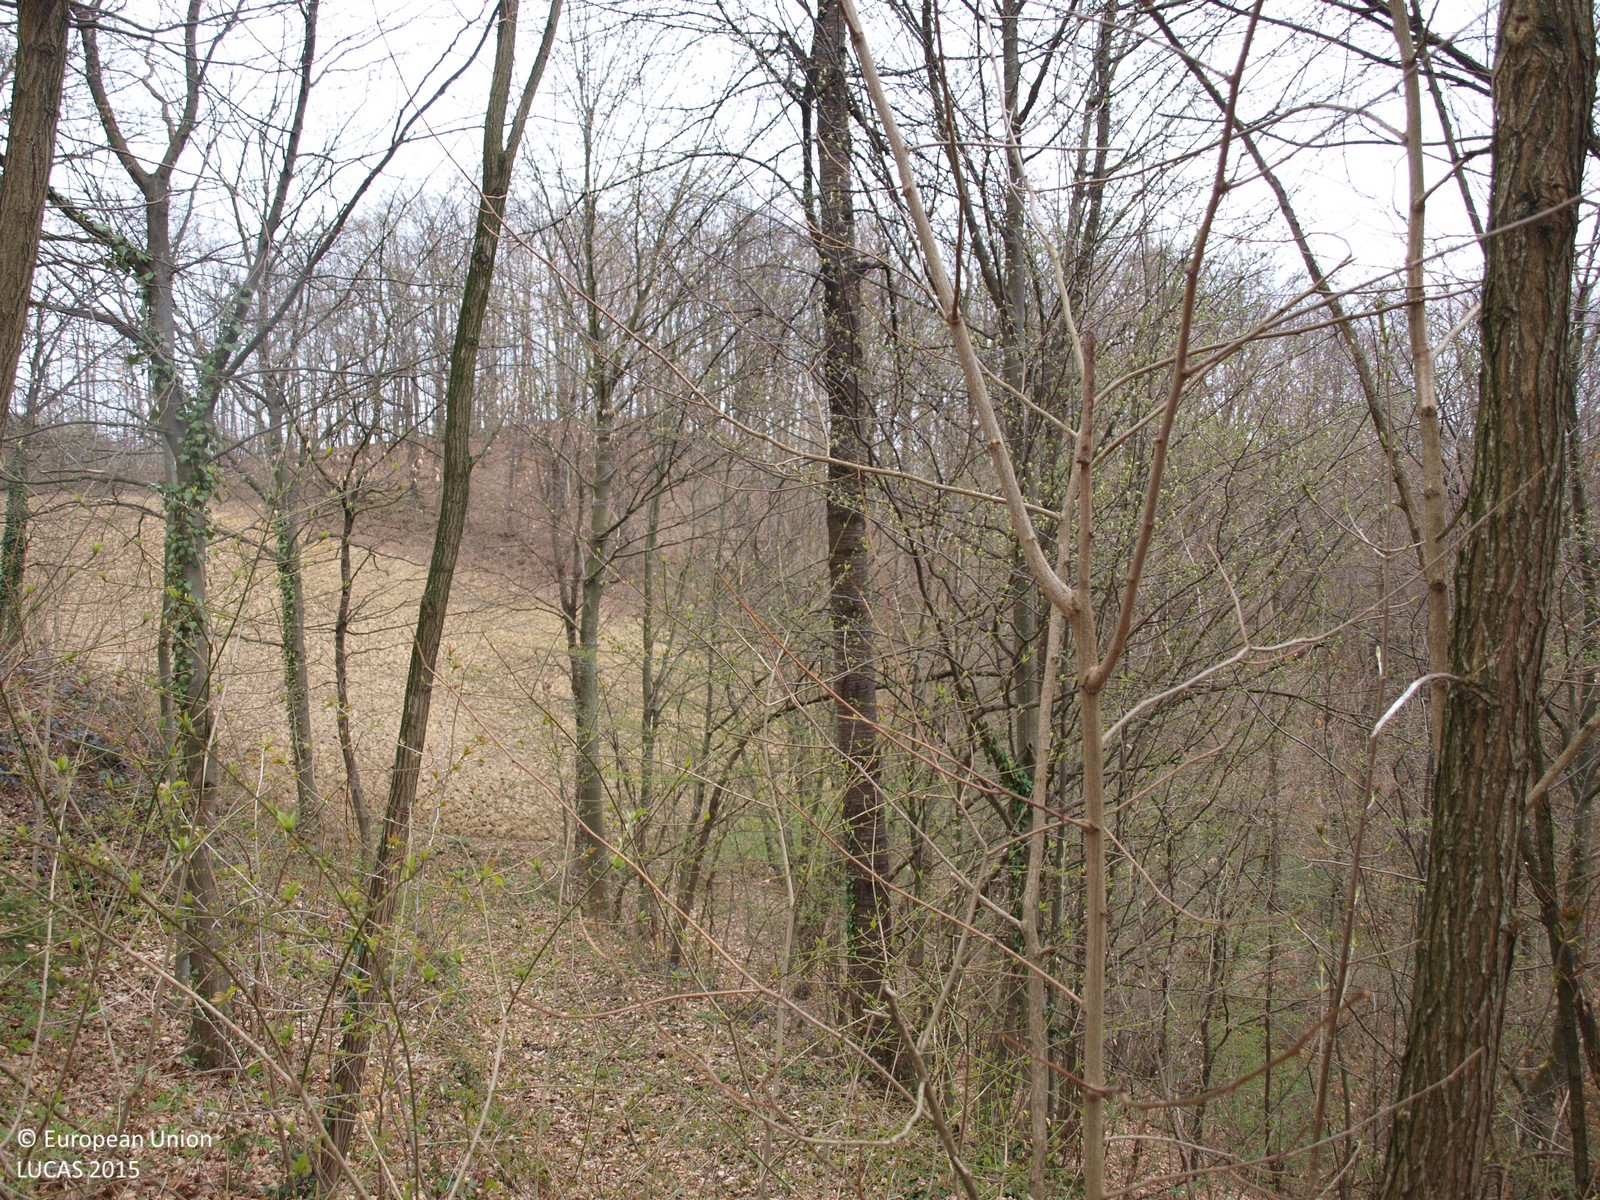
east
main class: Woodland
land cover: Broadleaved woodland
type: mesophytic deciduous forest
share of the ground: > 75 %
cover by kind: broadleaved forest trees 90 %
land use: Forestry
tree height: > 5 m
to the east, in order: Broadleaved woodland; Spontaneously vegetated surfaces; Broadleaved woodland; Paved roads, cycling and walking lanes; Broadleaved woodland; Electric lines; Broadleaved woodland; Grassland with sparse tree/shrub cover
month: April
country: HR
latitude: 46.1806
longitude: 15.7113
